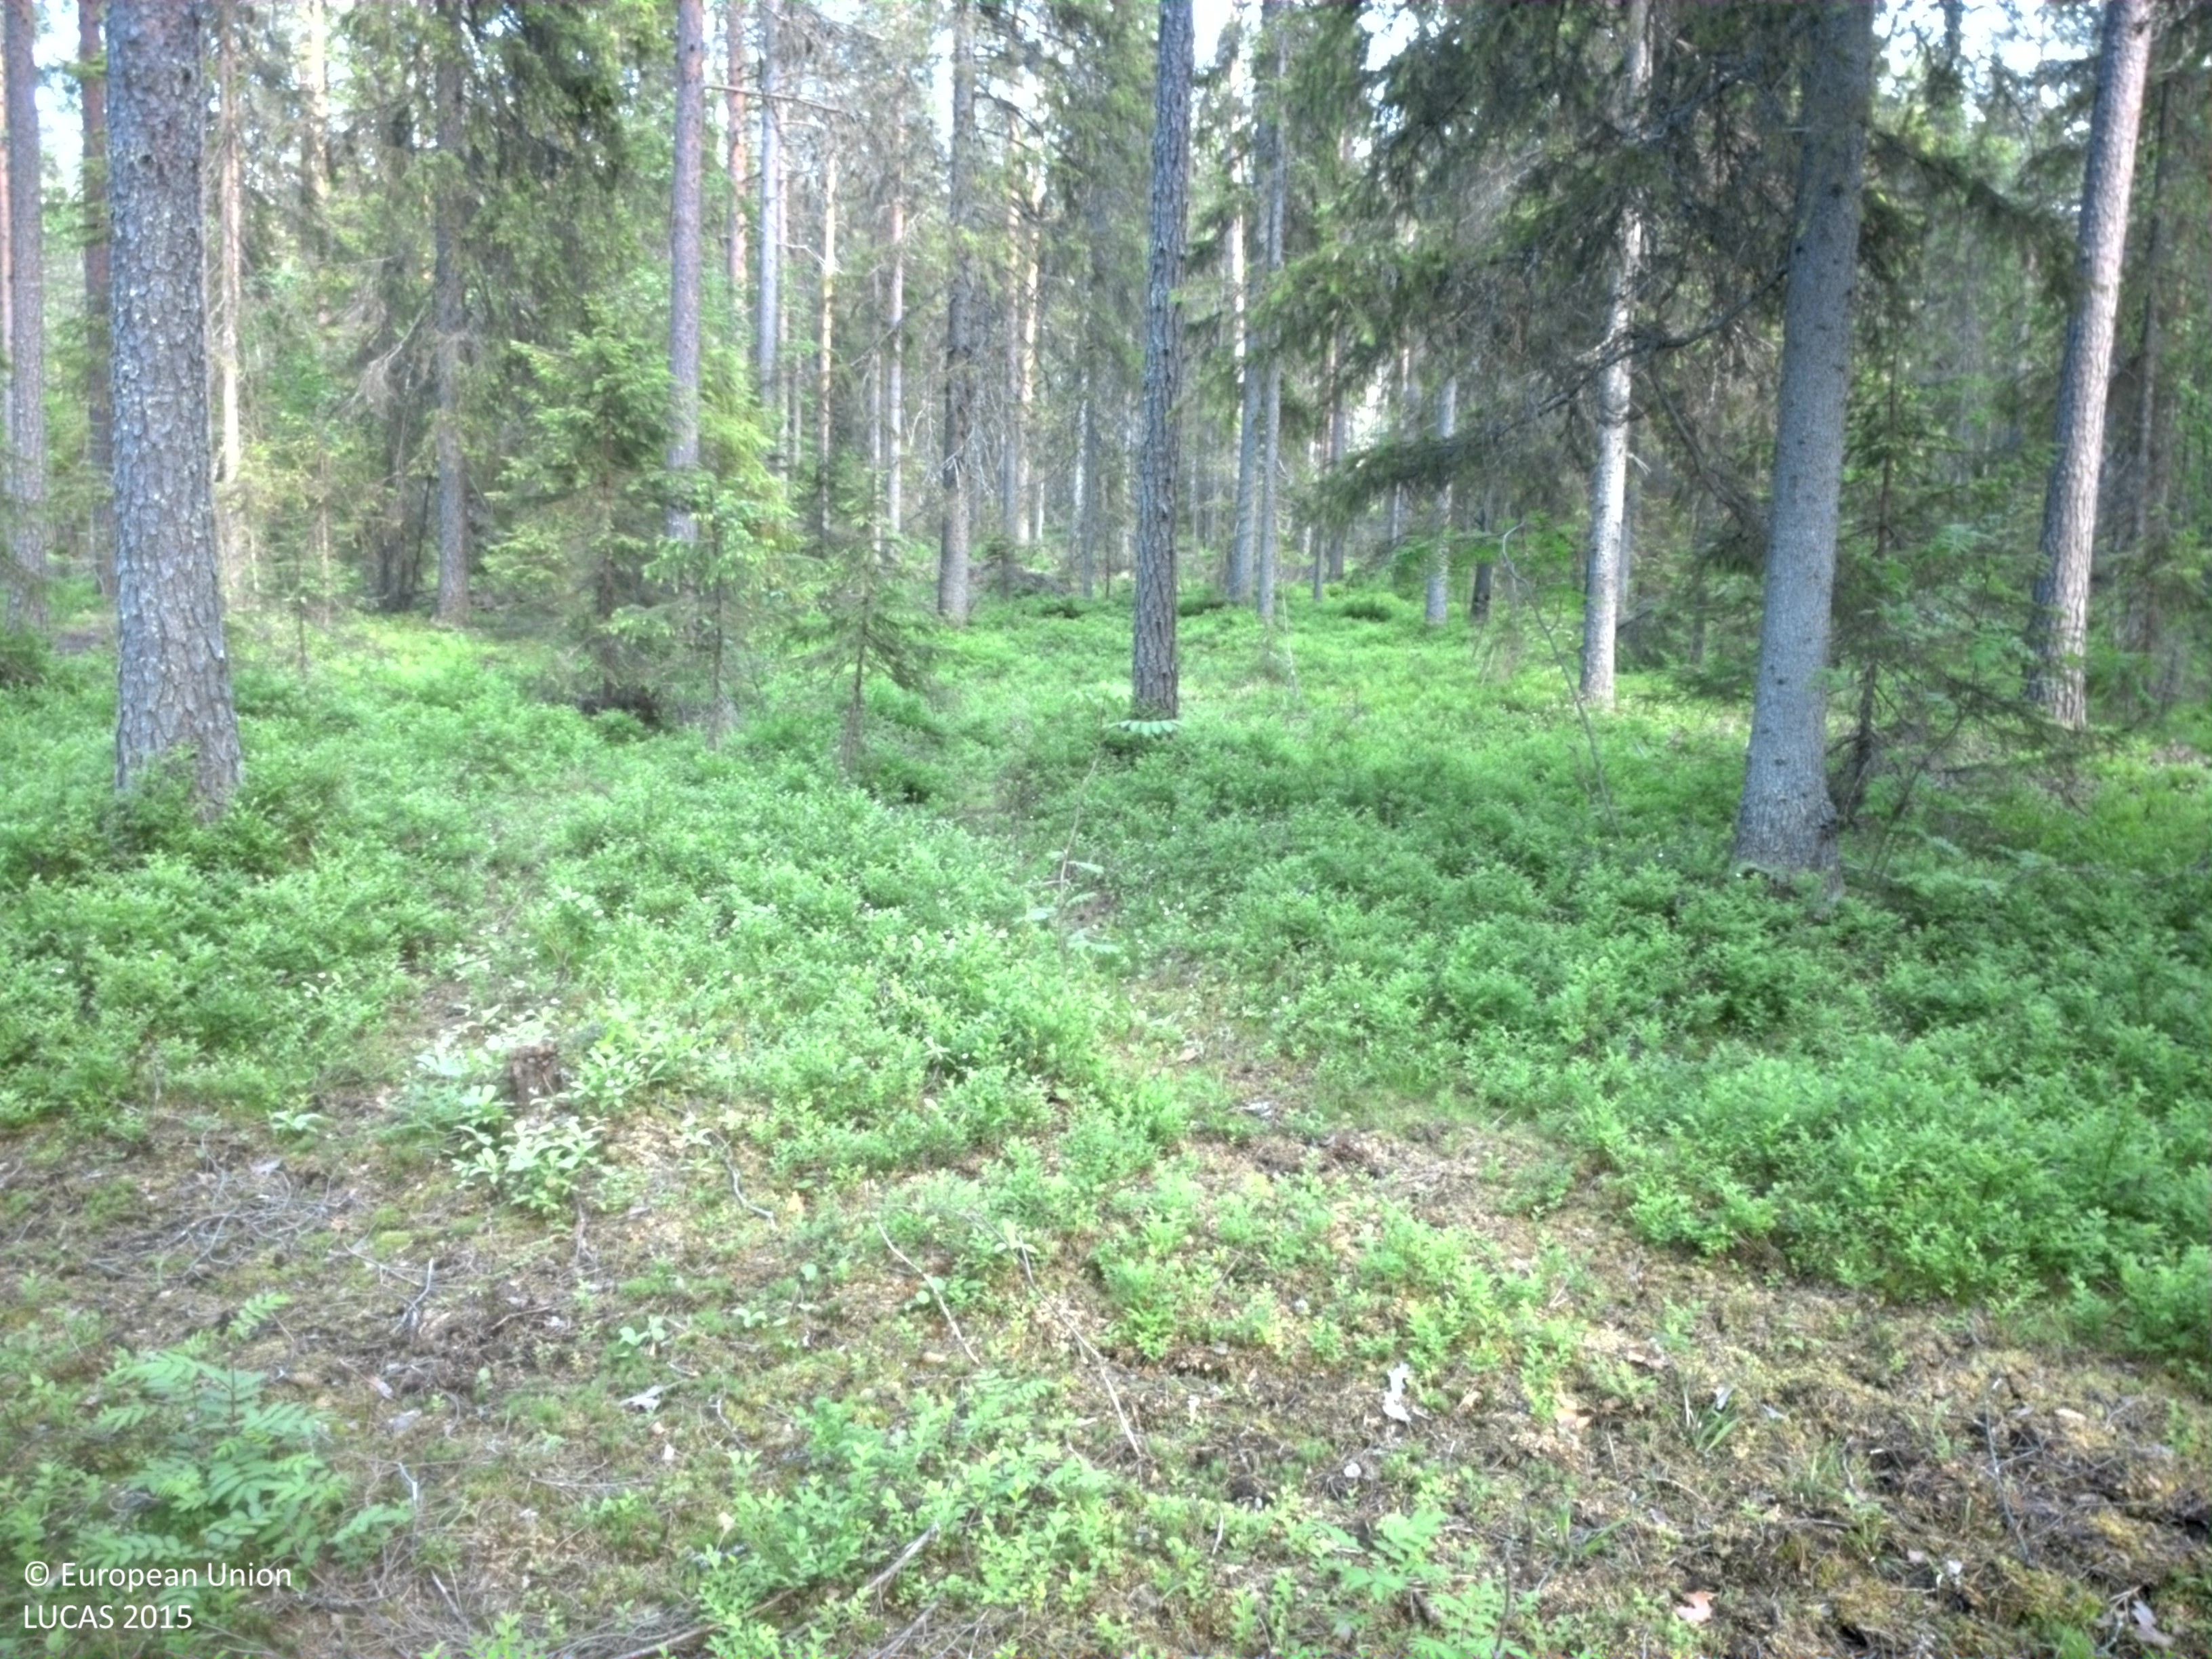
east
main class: Woodland
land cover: Pine dominated coniferous woodland
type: boreal forest
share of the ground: 25 - 50 %
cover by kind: shrubs 60 %, coniferous forest trees 40 %
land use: Forestry
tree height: > 5 m
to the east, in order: Pine dominated coniferous woodland; Tracks; Pine dominated coniferous woodland; Tracks; Pine dominated coniferous woodland; Tracks; Pine dominated coniferous woodland
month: June
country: SE
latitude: 66.3229
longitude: 22.7639
